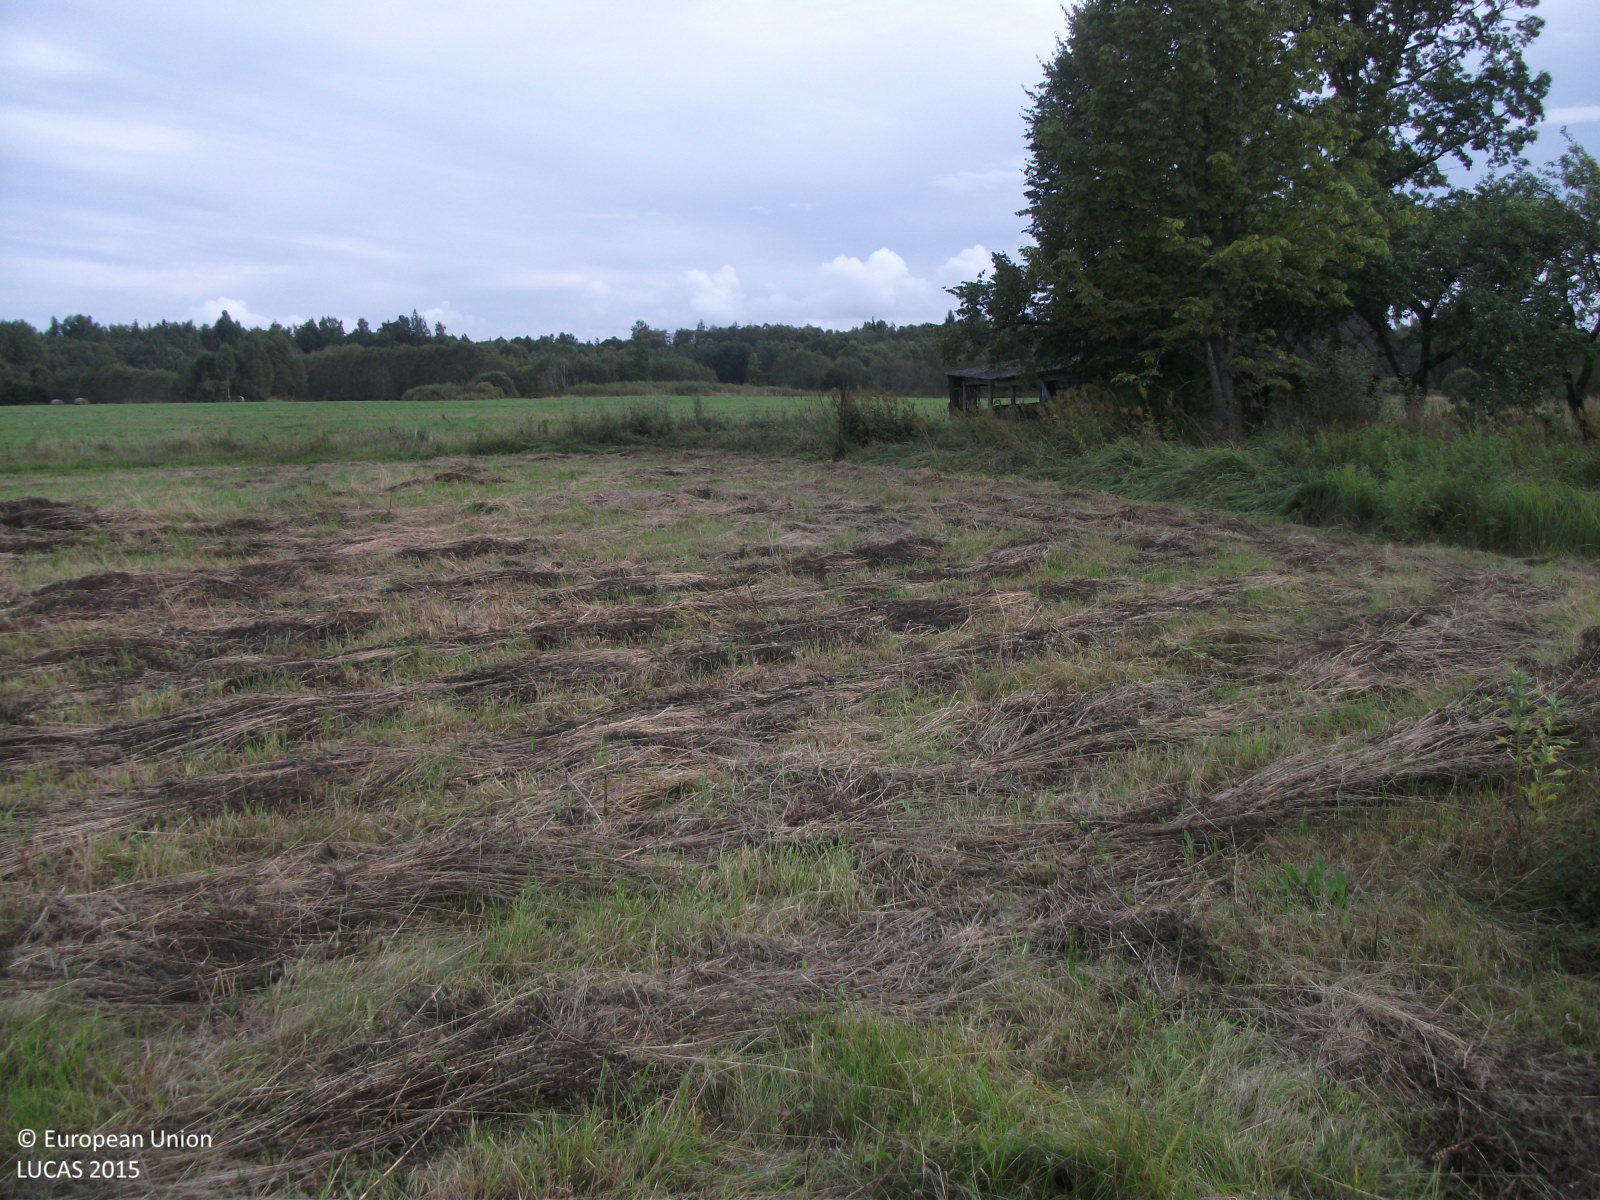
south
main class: Grassland
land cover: Grassland without tree/shrub cover
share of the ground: > 75 %
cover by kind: herbaceous plants 100 %
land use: Agriculture (excluding fallow land and kitchen gardens)
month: September
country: LV
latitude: 57.6547
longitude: 24.7595
